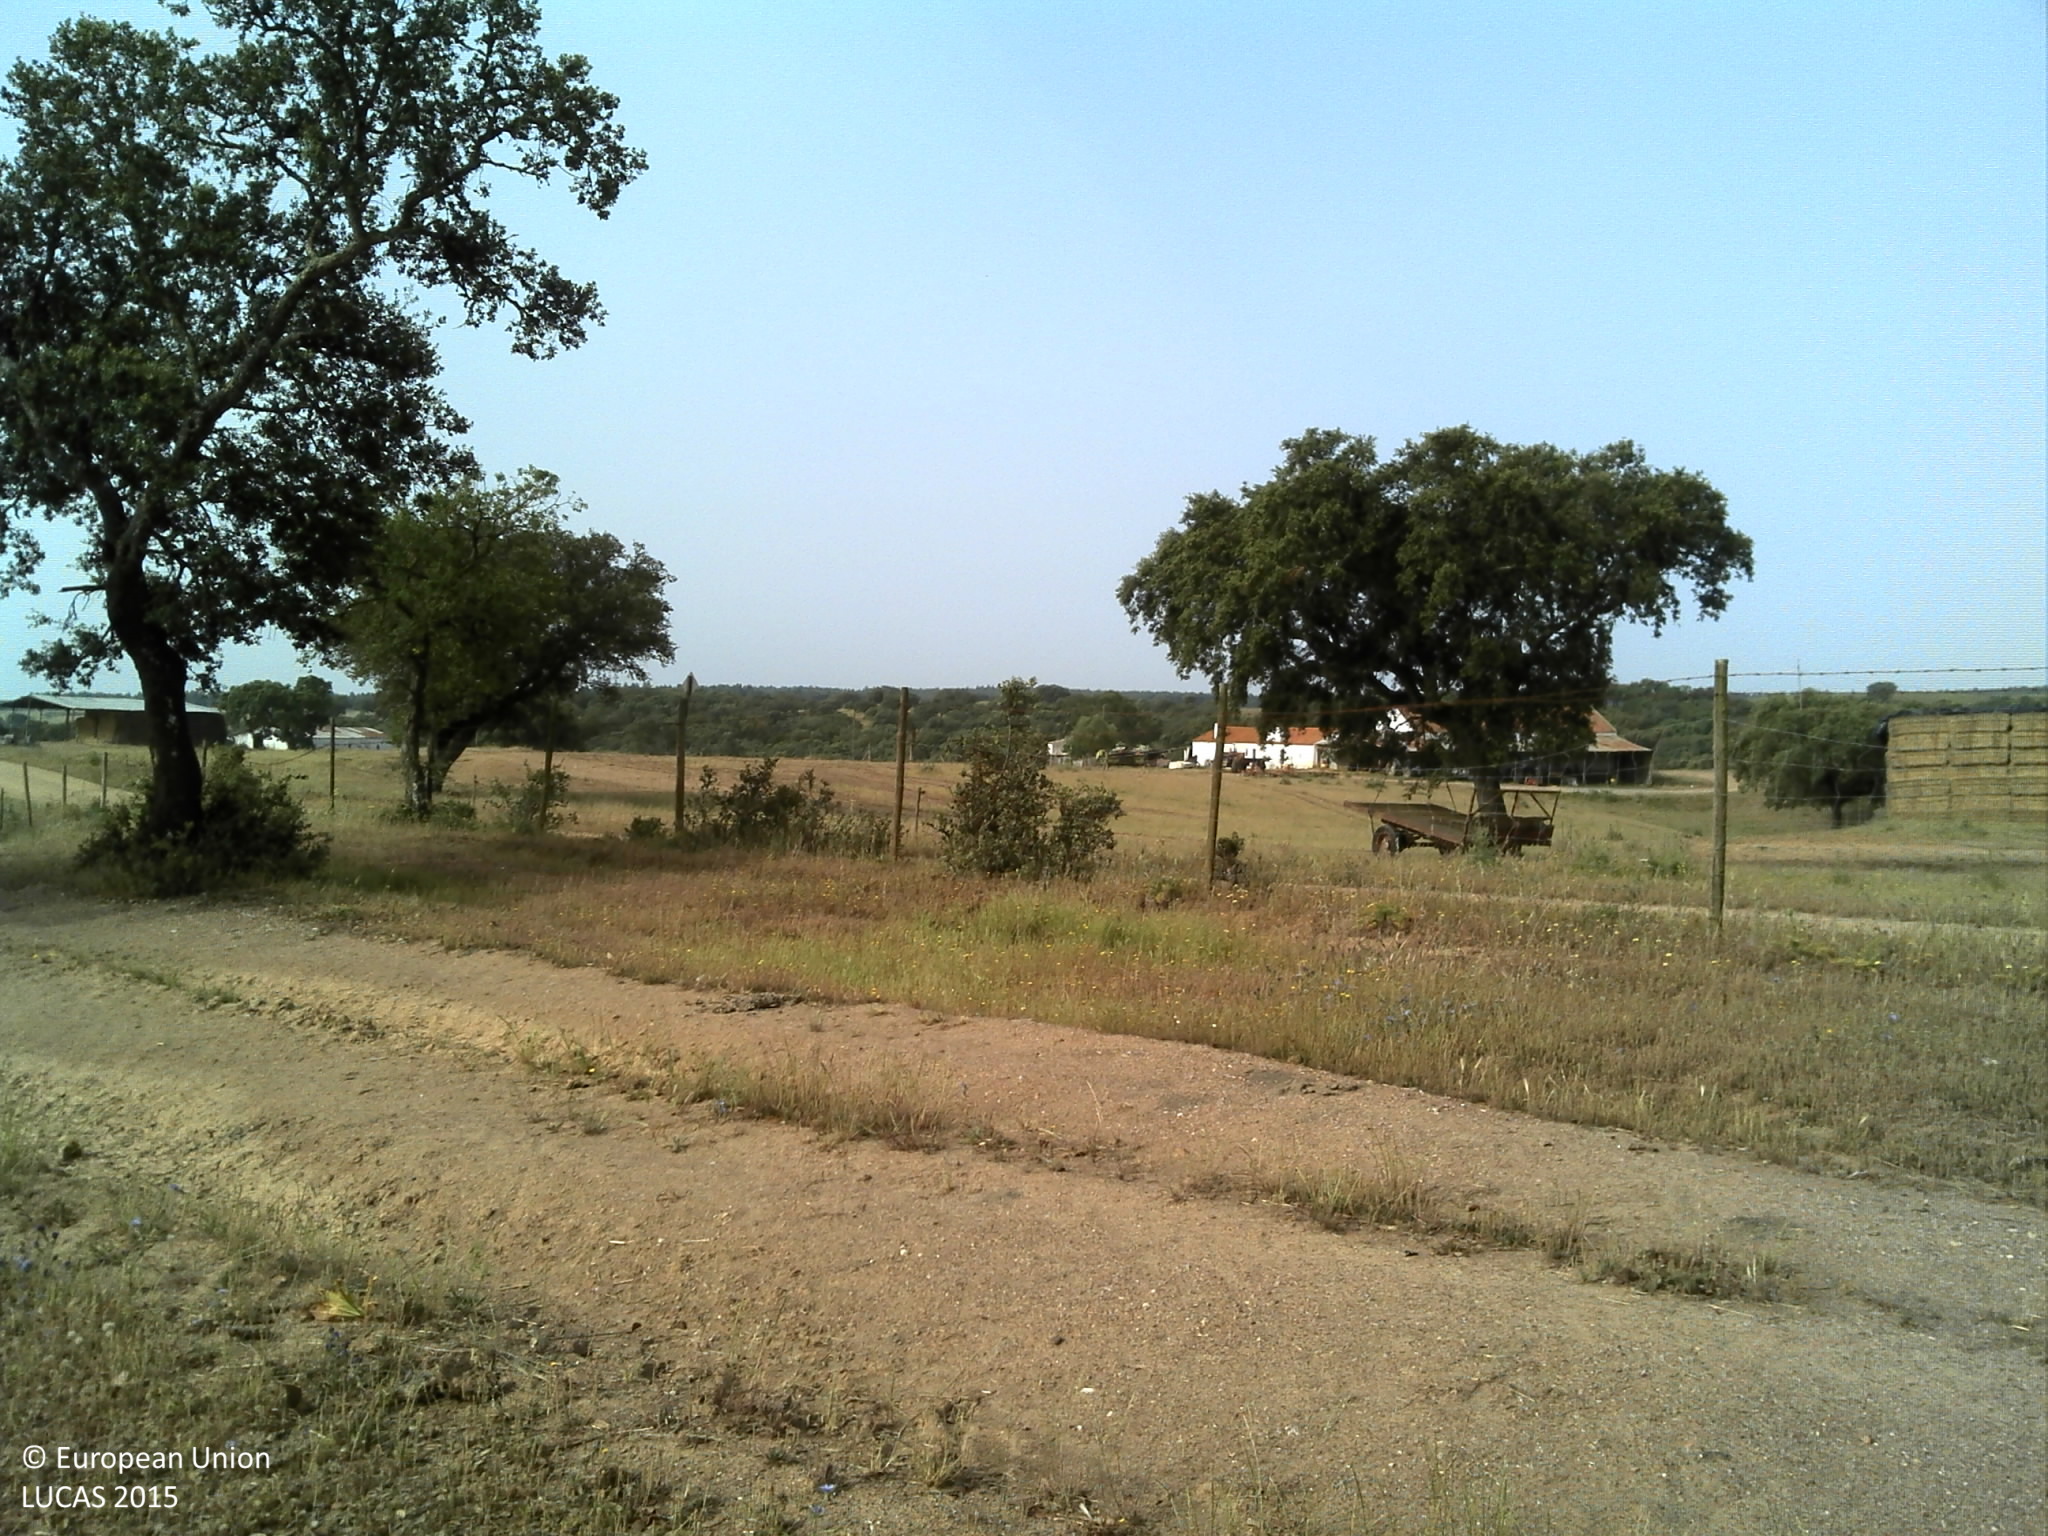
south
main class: Woodland
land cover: Broadleaved woodland
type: broadleaved evergreen forest
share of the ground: 25 - 50 %
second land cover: Grassland without tree/shrub cover
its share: 25 - 50 %
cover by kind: unconsolidated bare surface 40 %, broadleaved forest trees 30 %, herbaceous plants 30 %
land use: Agriculture (excluding fallow land and kitchen gardens)
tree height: > 5 m
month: May
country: PT
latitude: 38.4423
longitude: -8.4627
